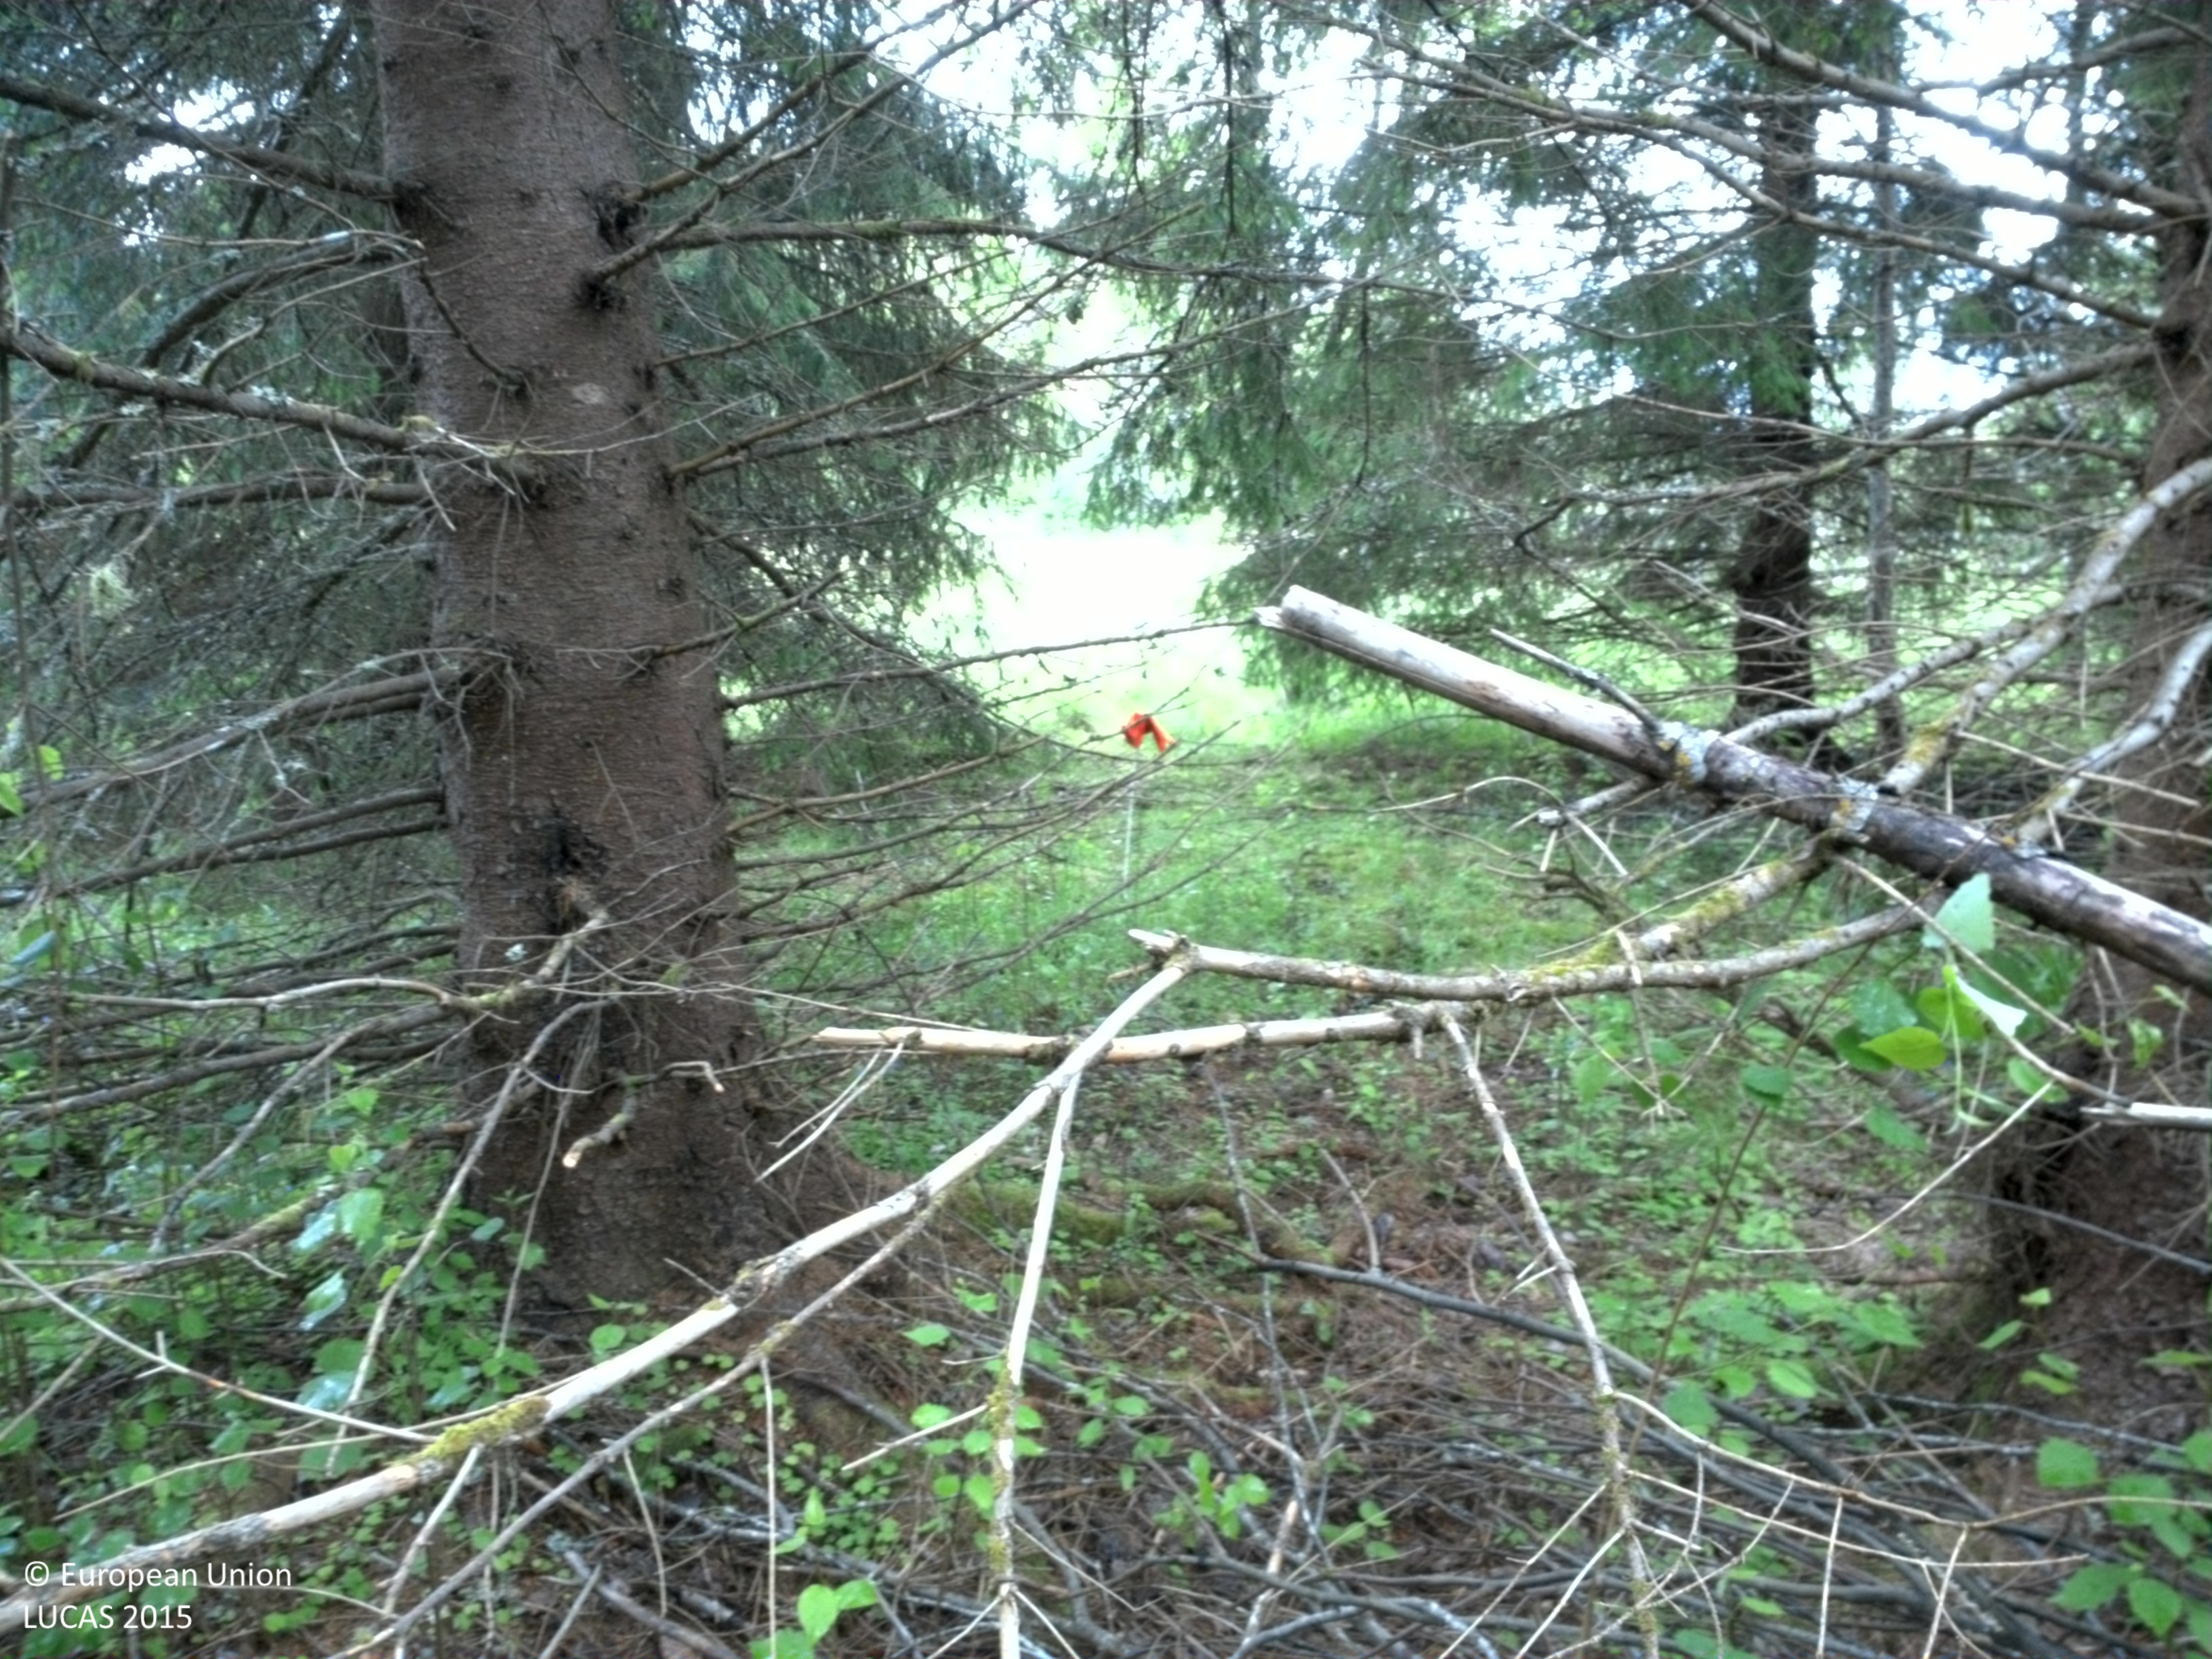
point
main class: Woodland
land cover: Spruce dominated mixed woodland
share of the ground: 50 - 75 %
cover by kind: coniferous forest trees 40 %, herbaceous plants 30 %, broadleaved forest trees 20 %, lichens and mosses 10 %
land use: Forestry
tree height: > 5 m
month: June
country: SE
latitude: 58.5848
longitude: 15.7220
